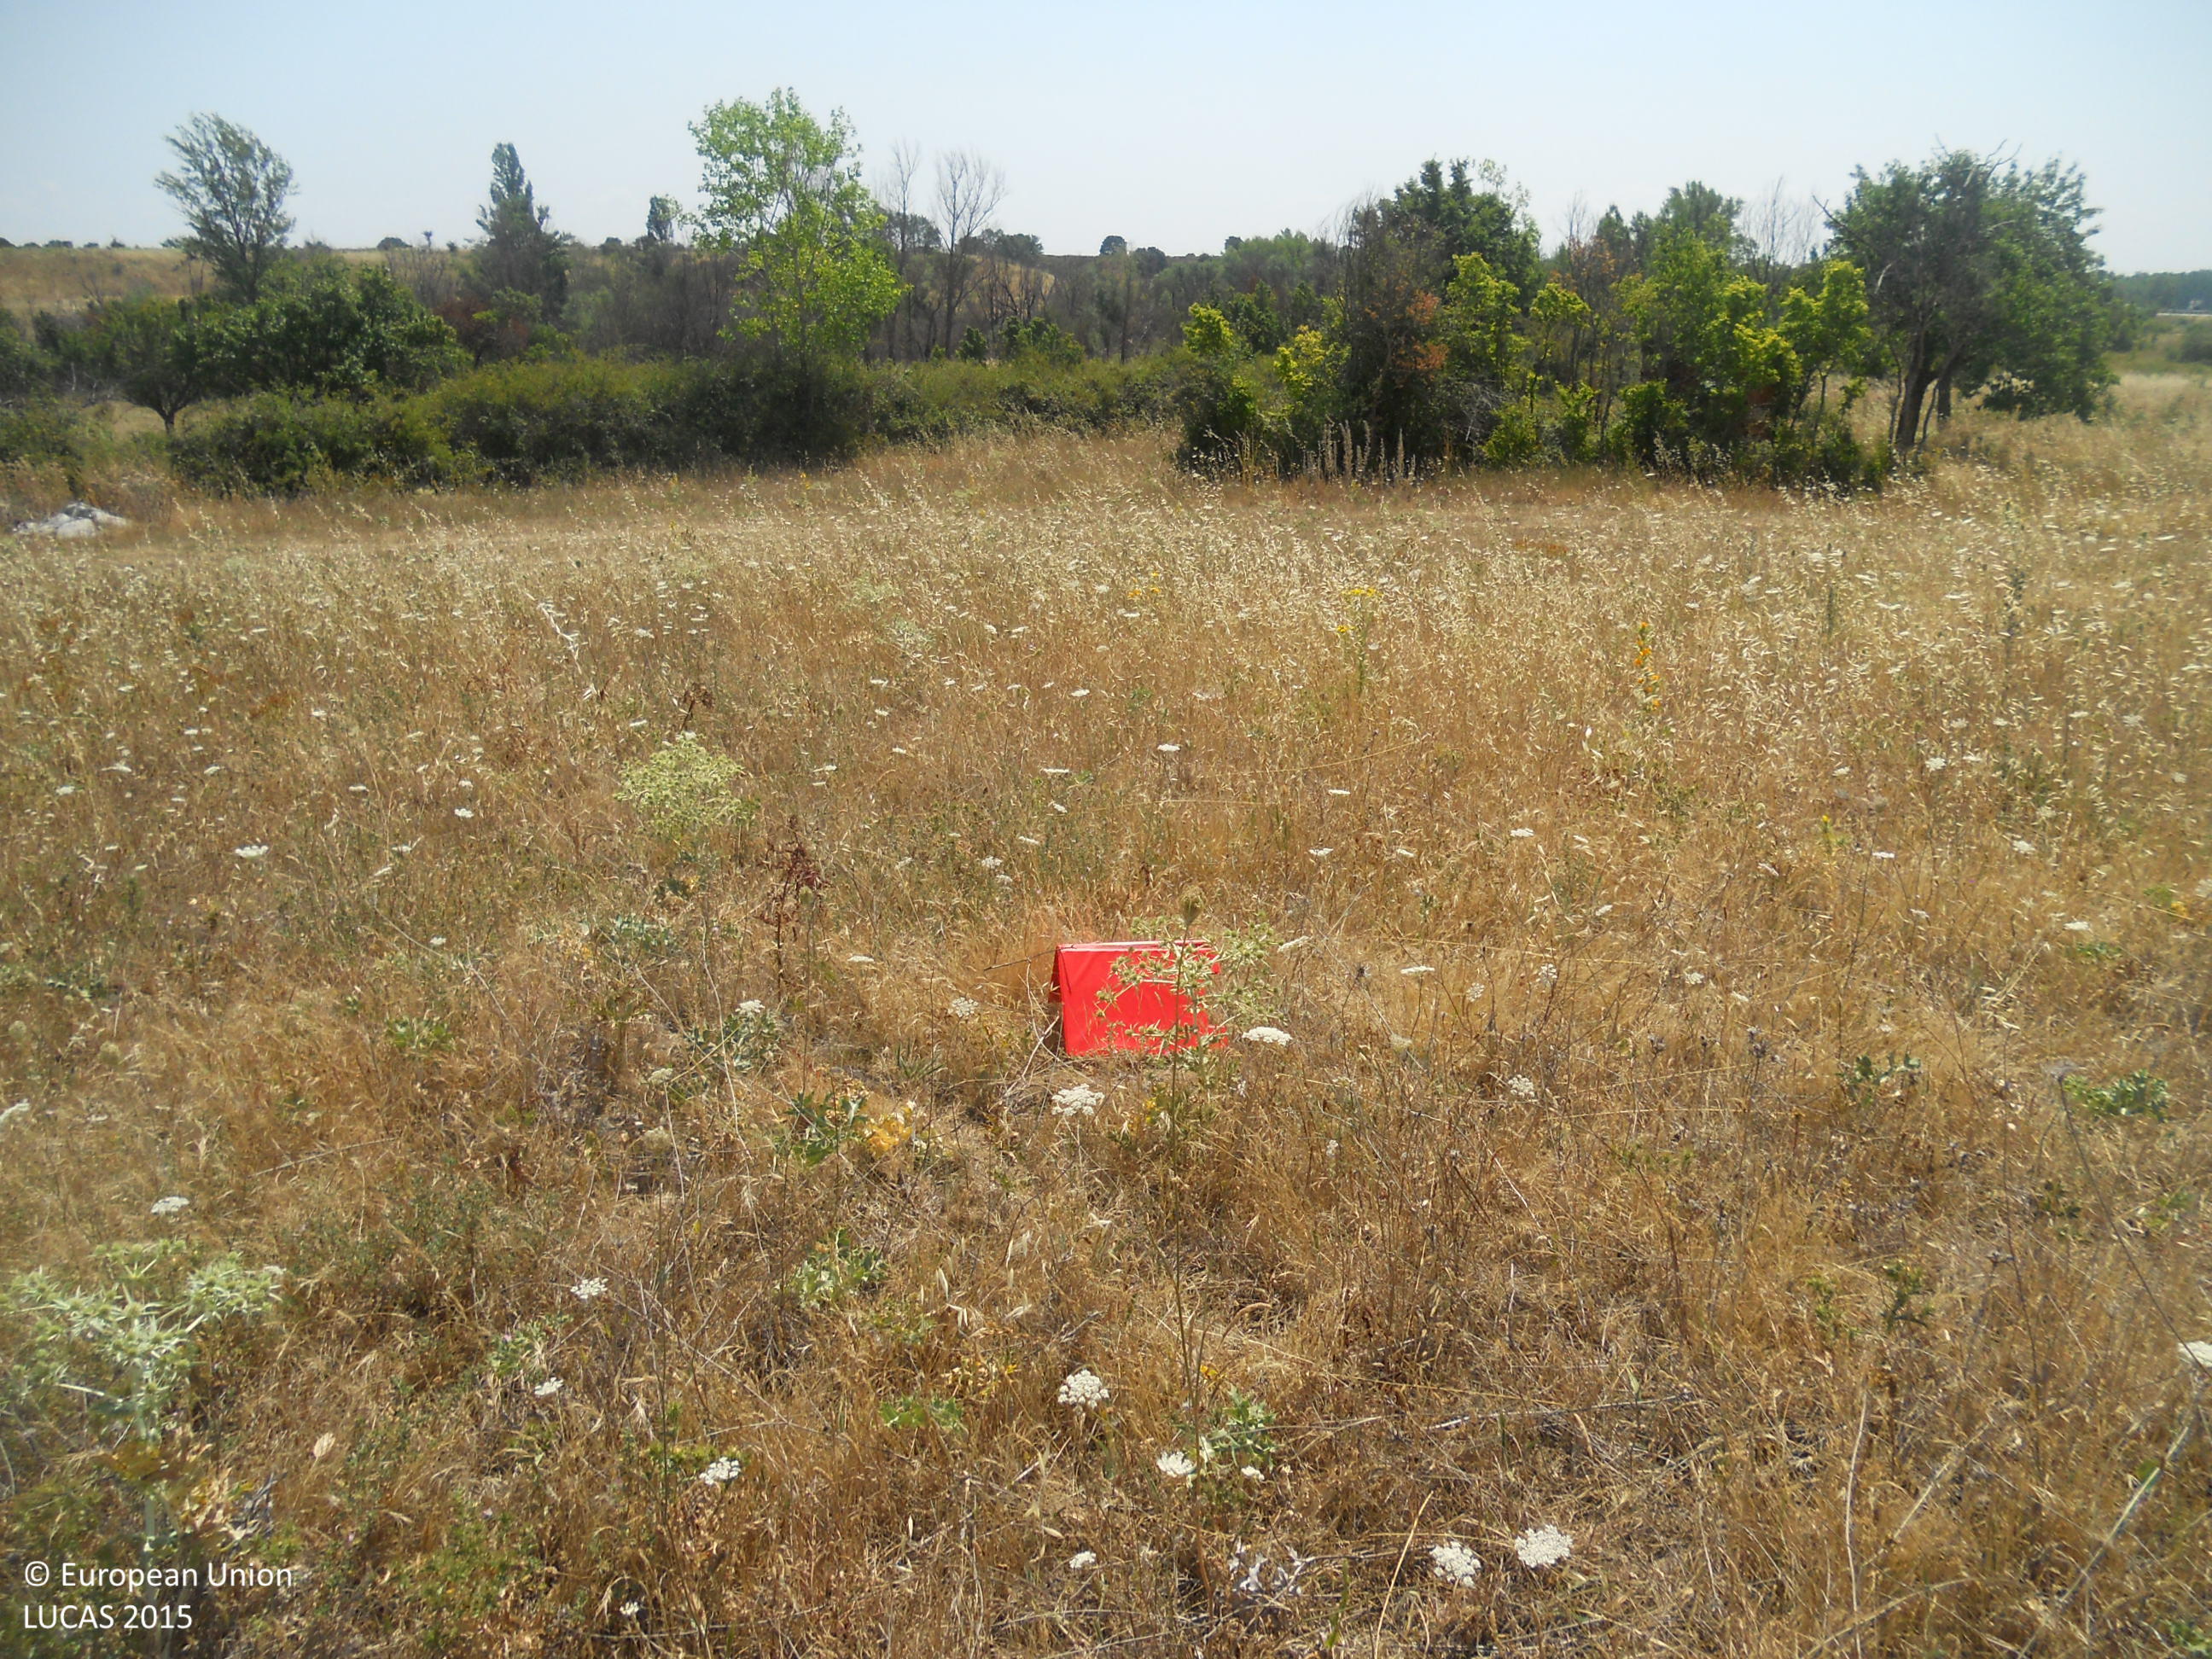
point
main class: Grassland
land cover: Grassland without tree/shrub cover
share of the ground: > 75 %
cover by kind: herbaceous plants 100 %
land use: Semi-natural and natural areas not in use
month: July
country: ES
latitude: 42.5738
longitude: -5.6064
